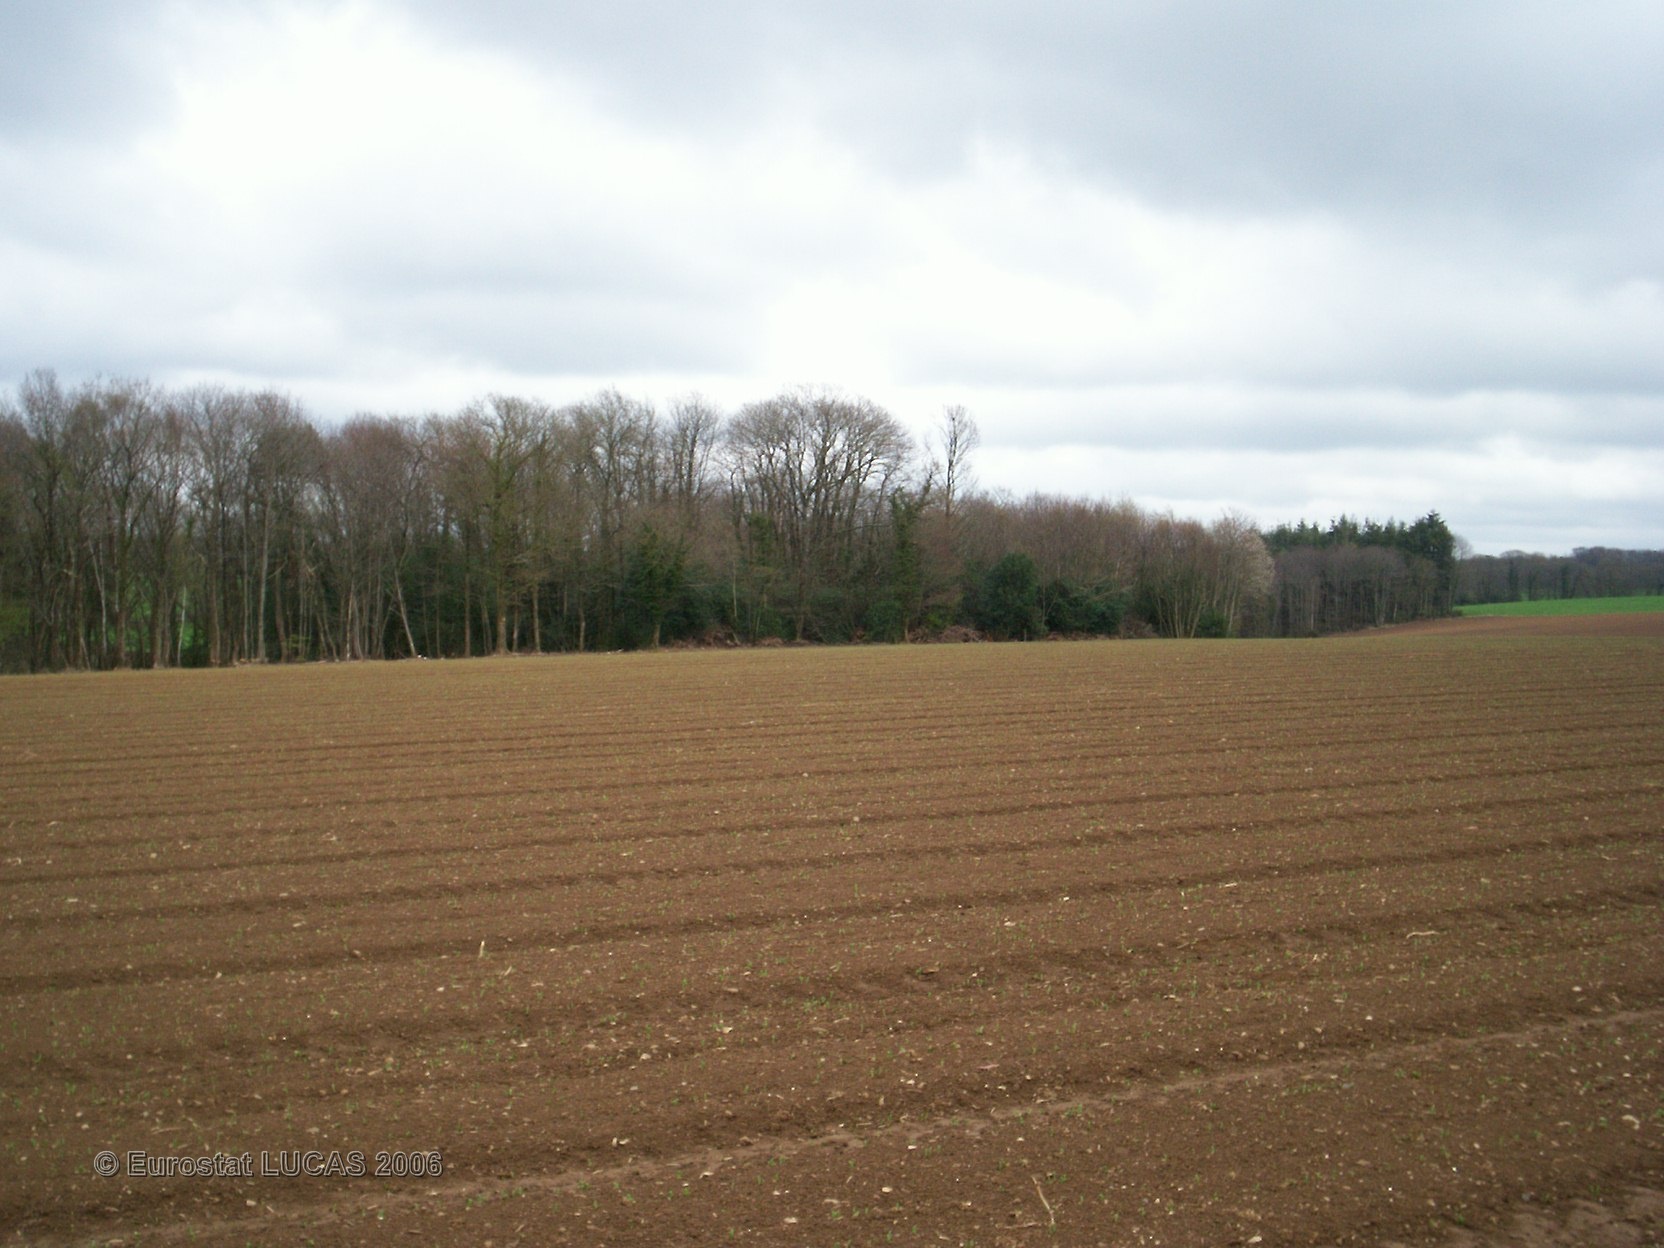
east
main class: Cropland
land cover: Other fresh vegetables
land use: Agriculture (excluding fallow land and kitchen gardens)
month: April
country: FR
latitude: 47.7760
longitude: -2.8622
